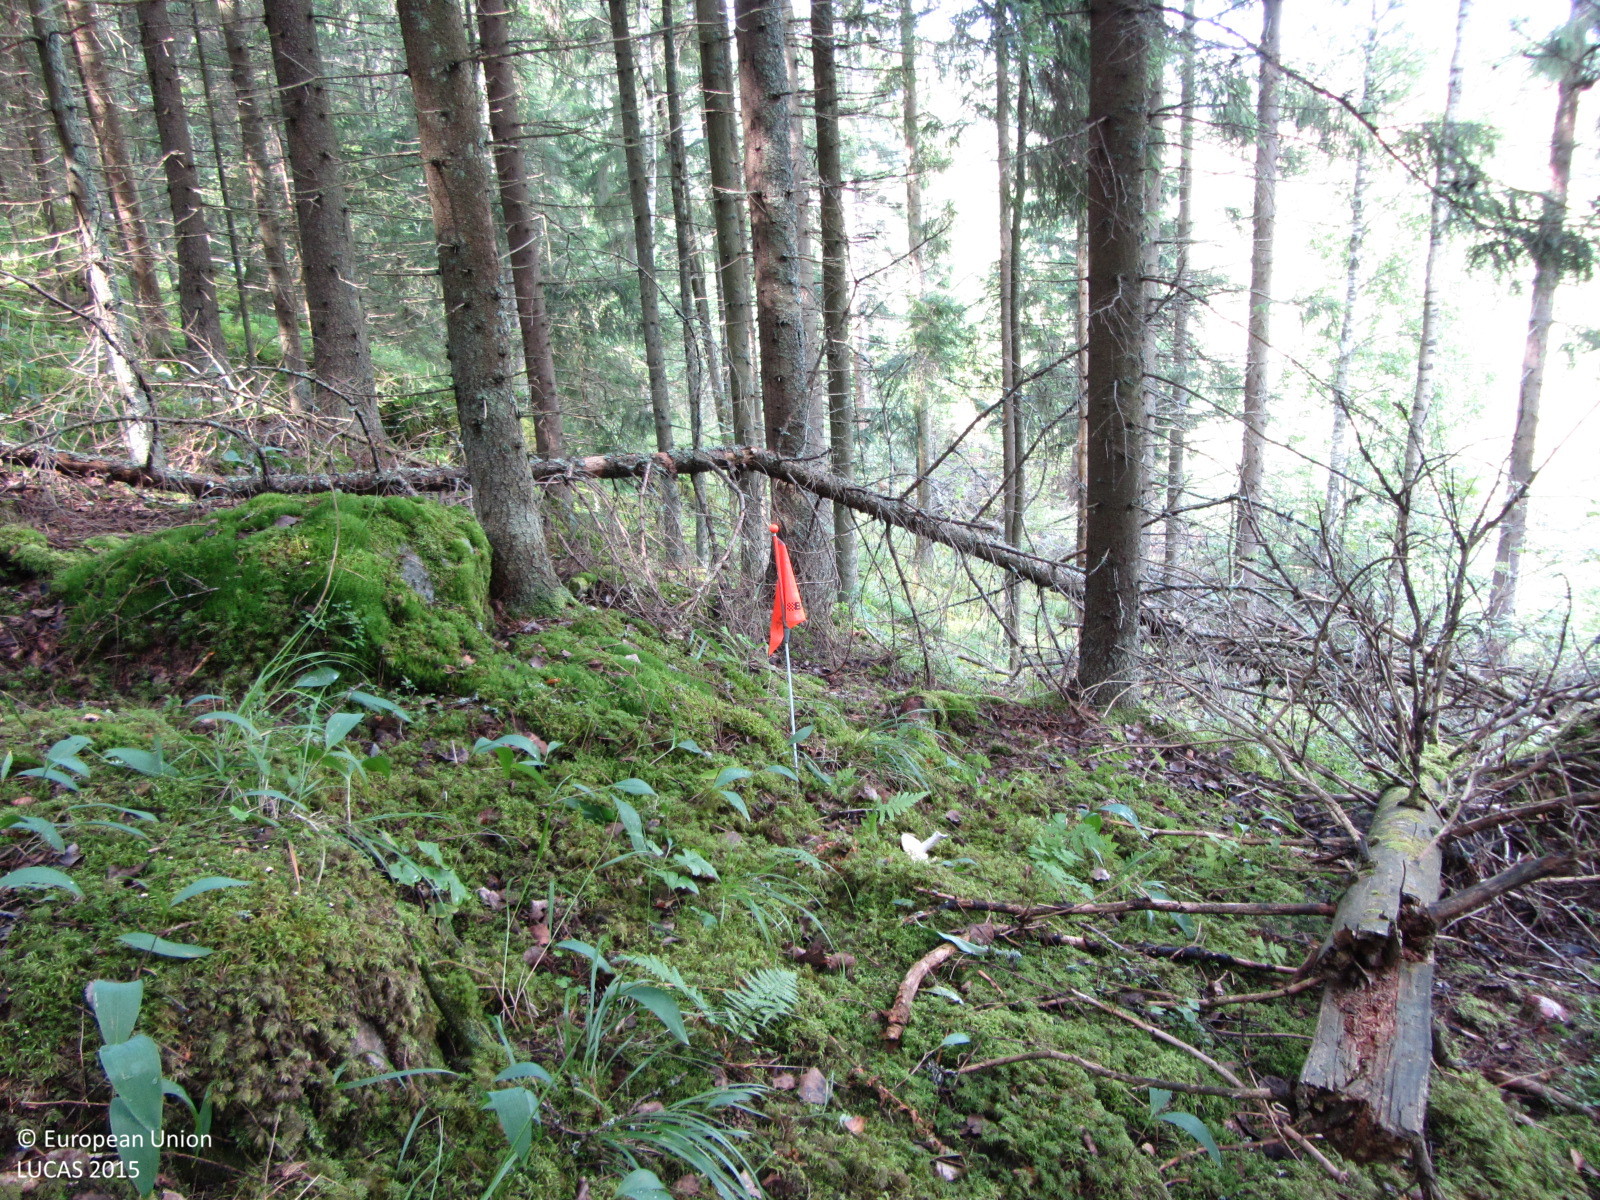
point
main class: Woodland
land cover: Spruce dominated mixed woodland
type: boreal forest
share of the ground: > 75 %
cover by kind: coniferous forest trees 50 %, broadleaved forest trees 40 %, shrubs 5 %, lichens and mosses 5 %
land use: Forestry
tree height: > 5 m
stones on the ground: < 10 %
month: August
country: FI
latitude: 60.1918
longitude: 24.1871
